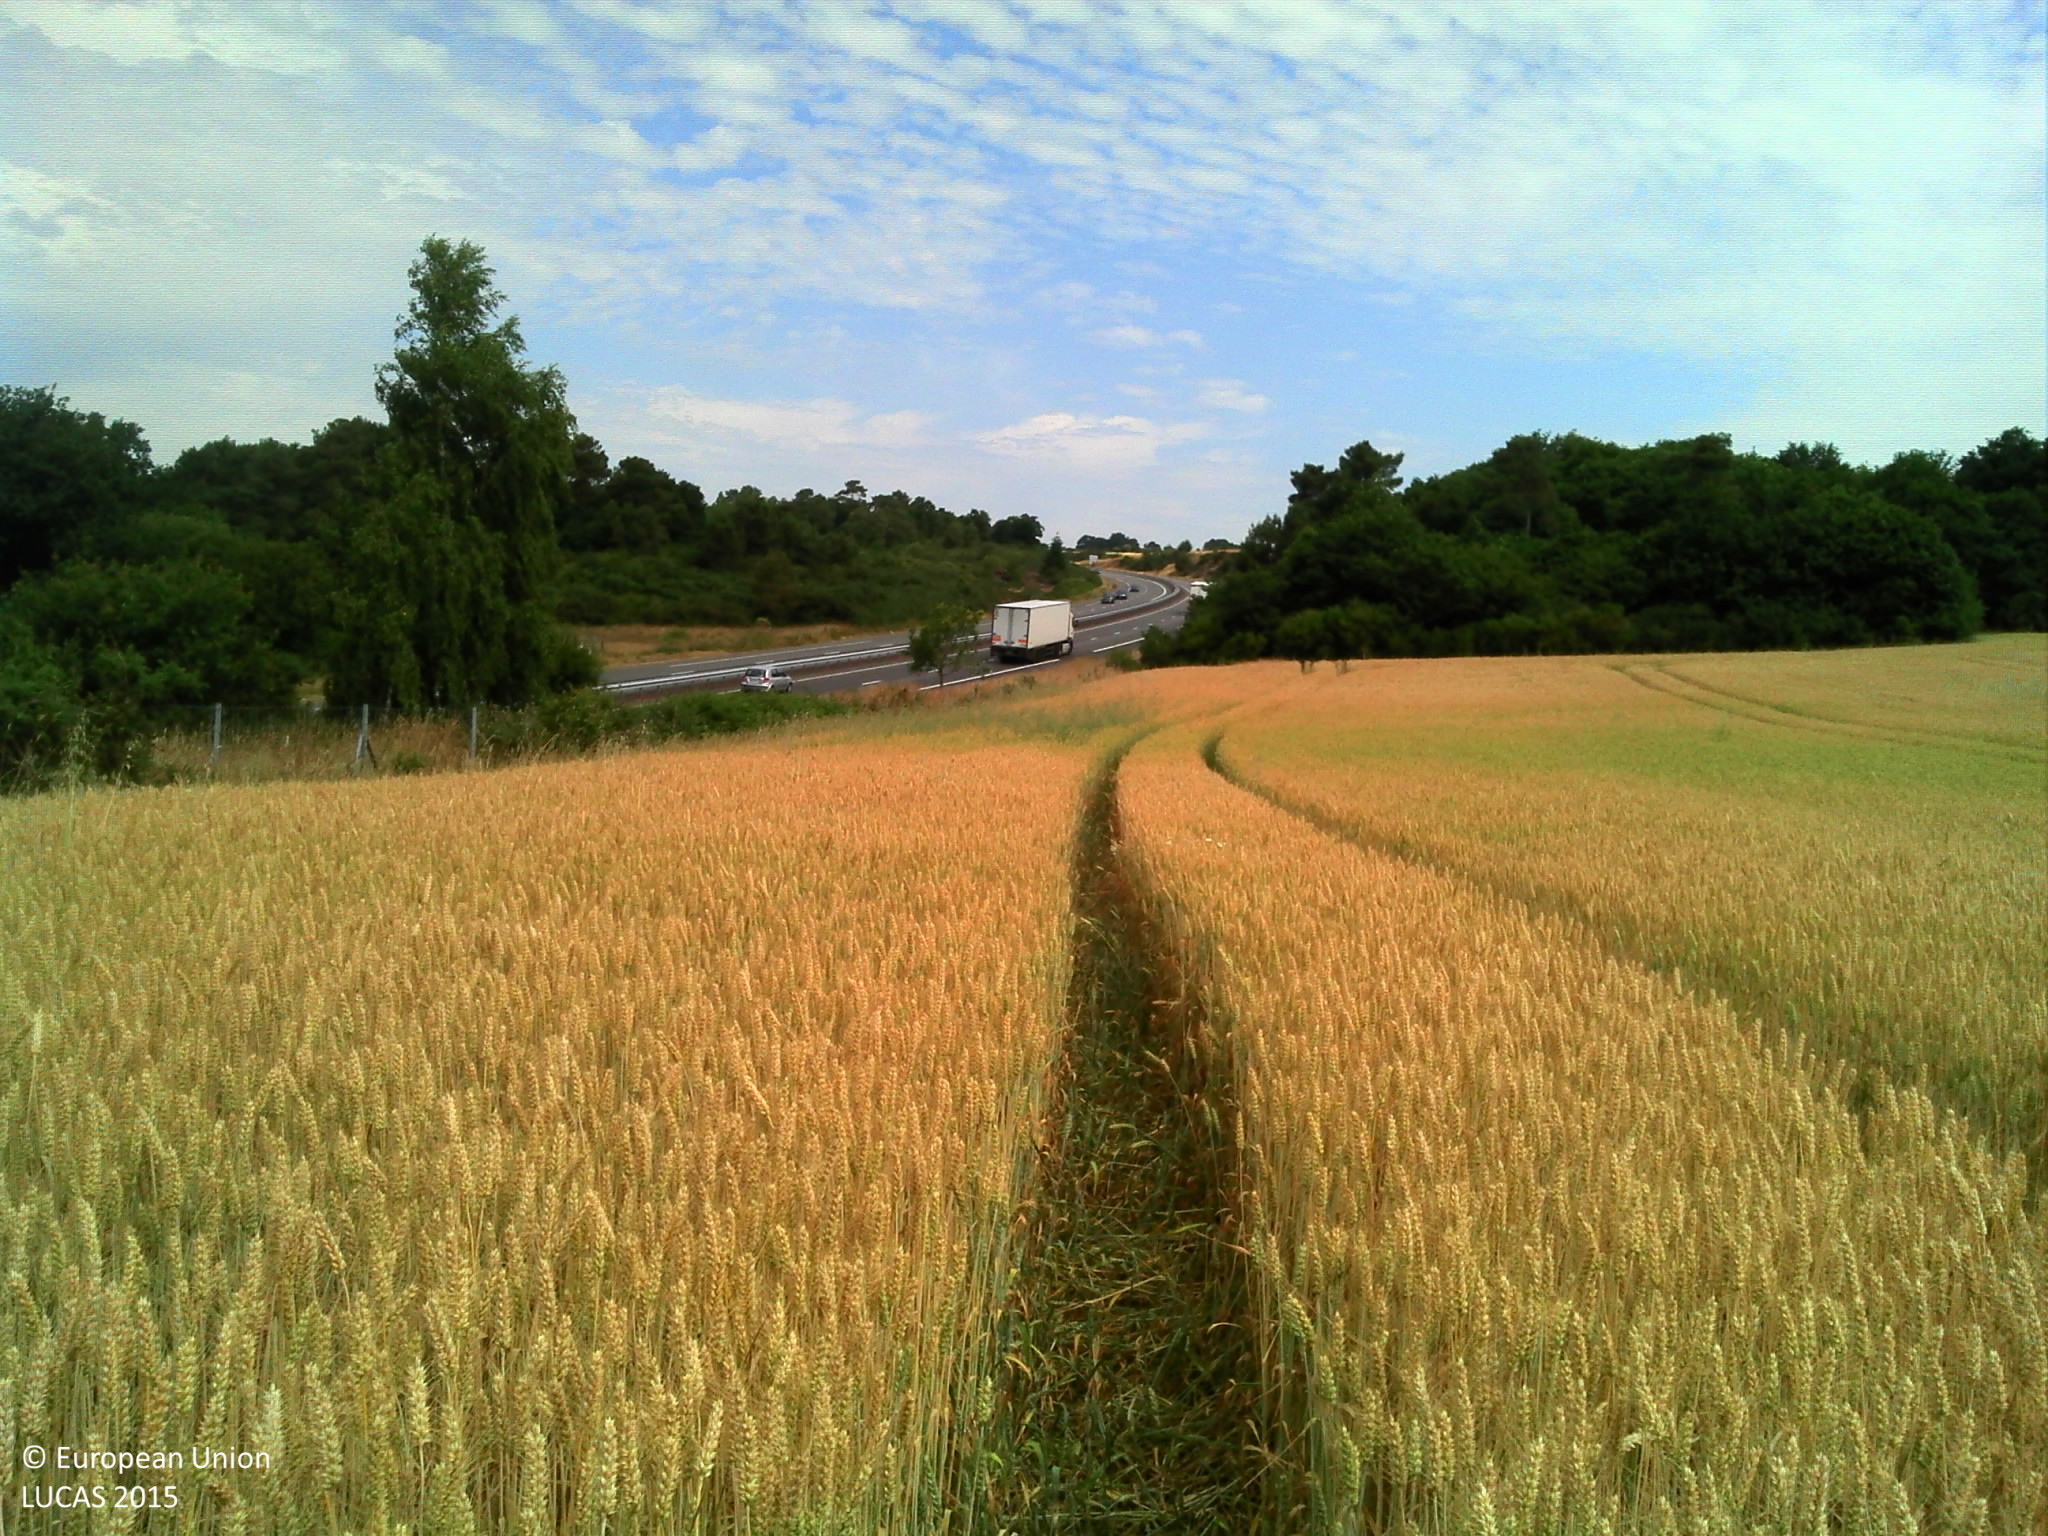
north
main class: Woodland
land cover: Broadleaved woodland
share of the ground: > 75 %
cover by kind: broadleaved forest trees 50 %, herbaceous plants 50 %
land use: Forestry
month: June
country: FR
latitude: 47.9554
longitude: -2.0917
